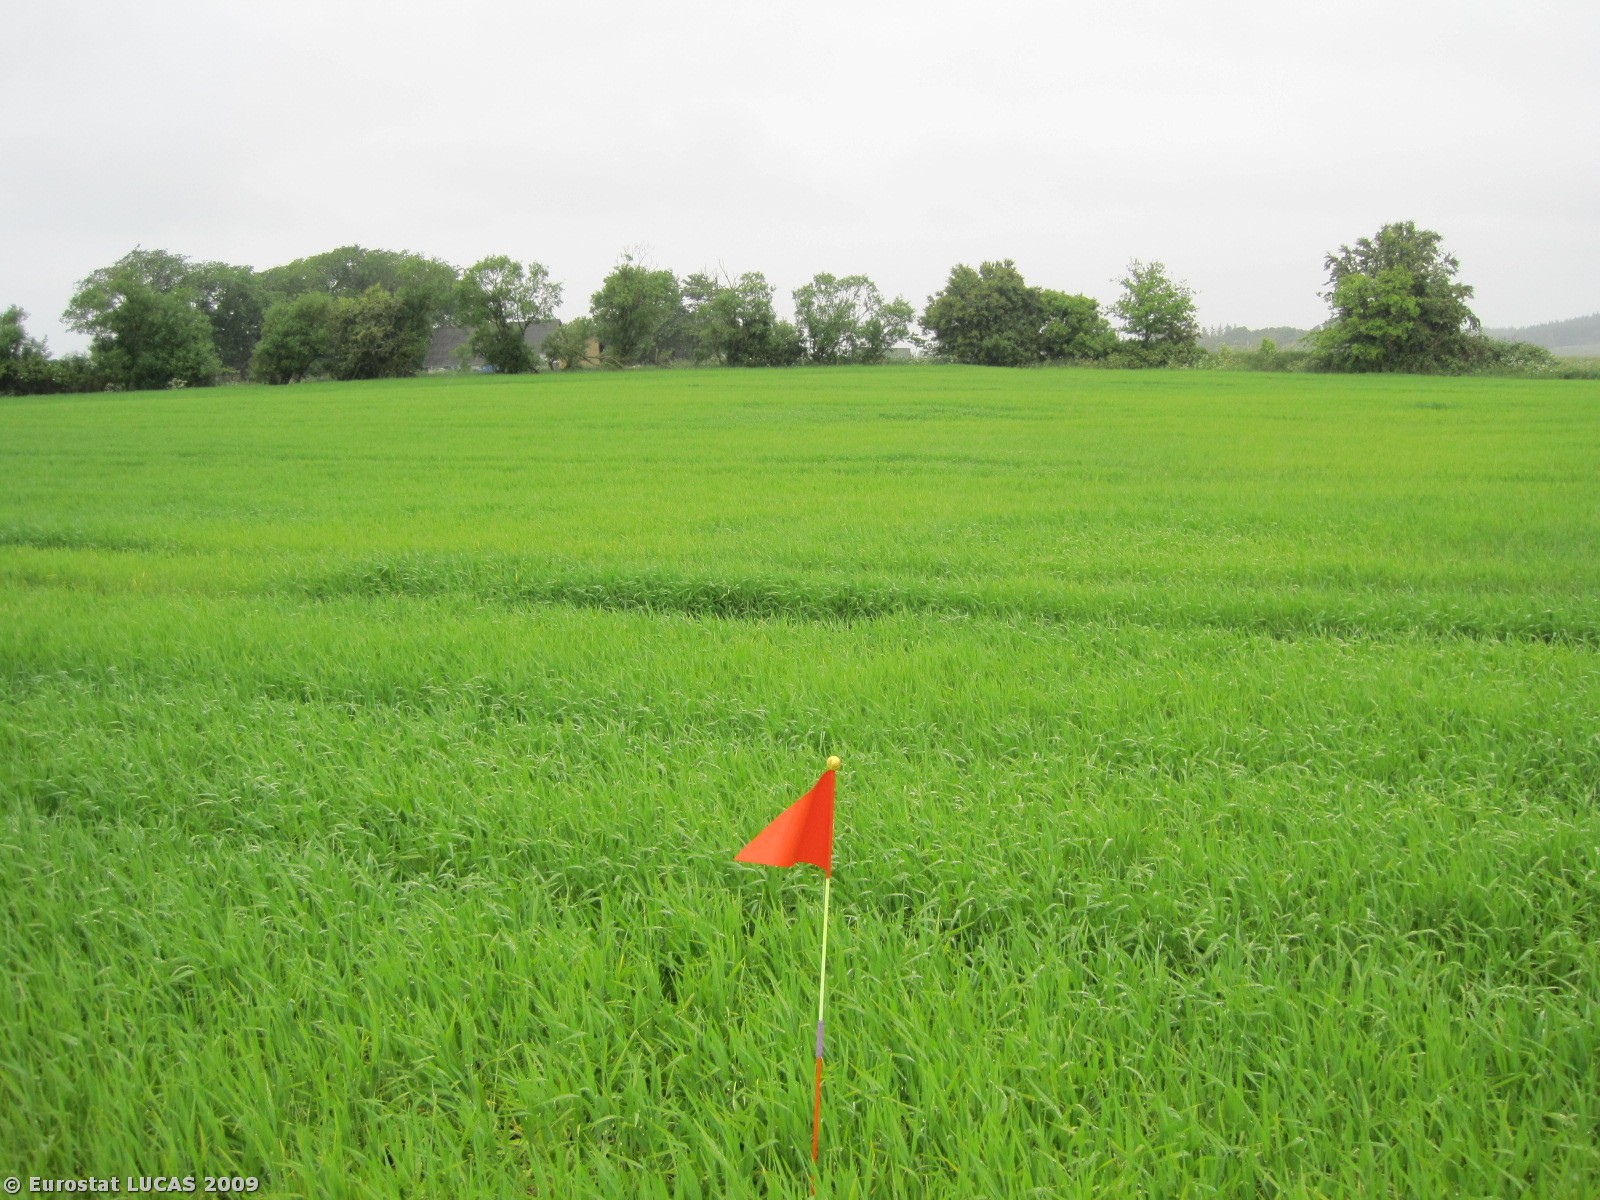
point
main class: Cropland
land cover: Barley
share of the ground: > 75 %
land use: Agriculture (excluding fallow land and kitchen gardens)
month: June
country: DK
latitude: 57.3563
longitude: 10.0830
